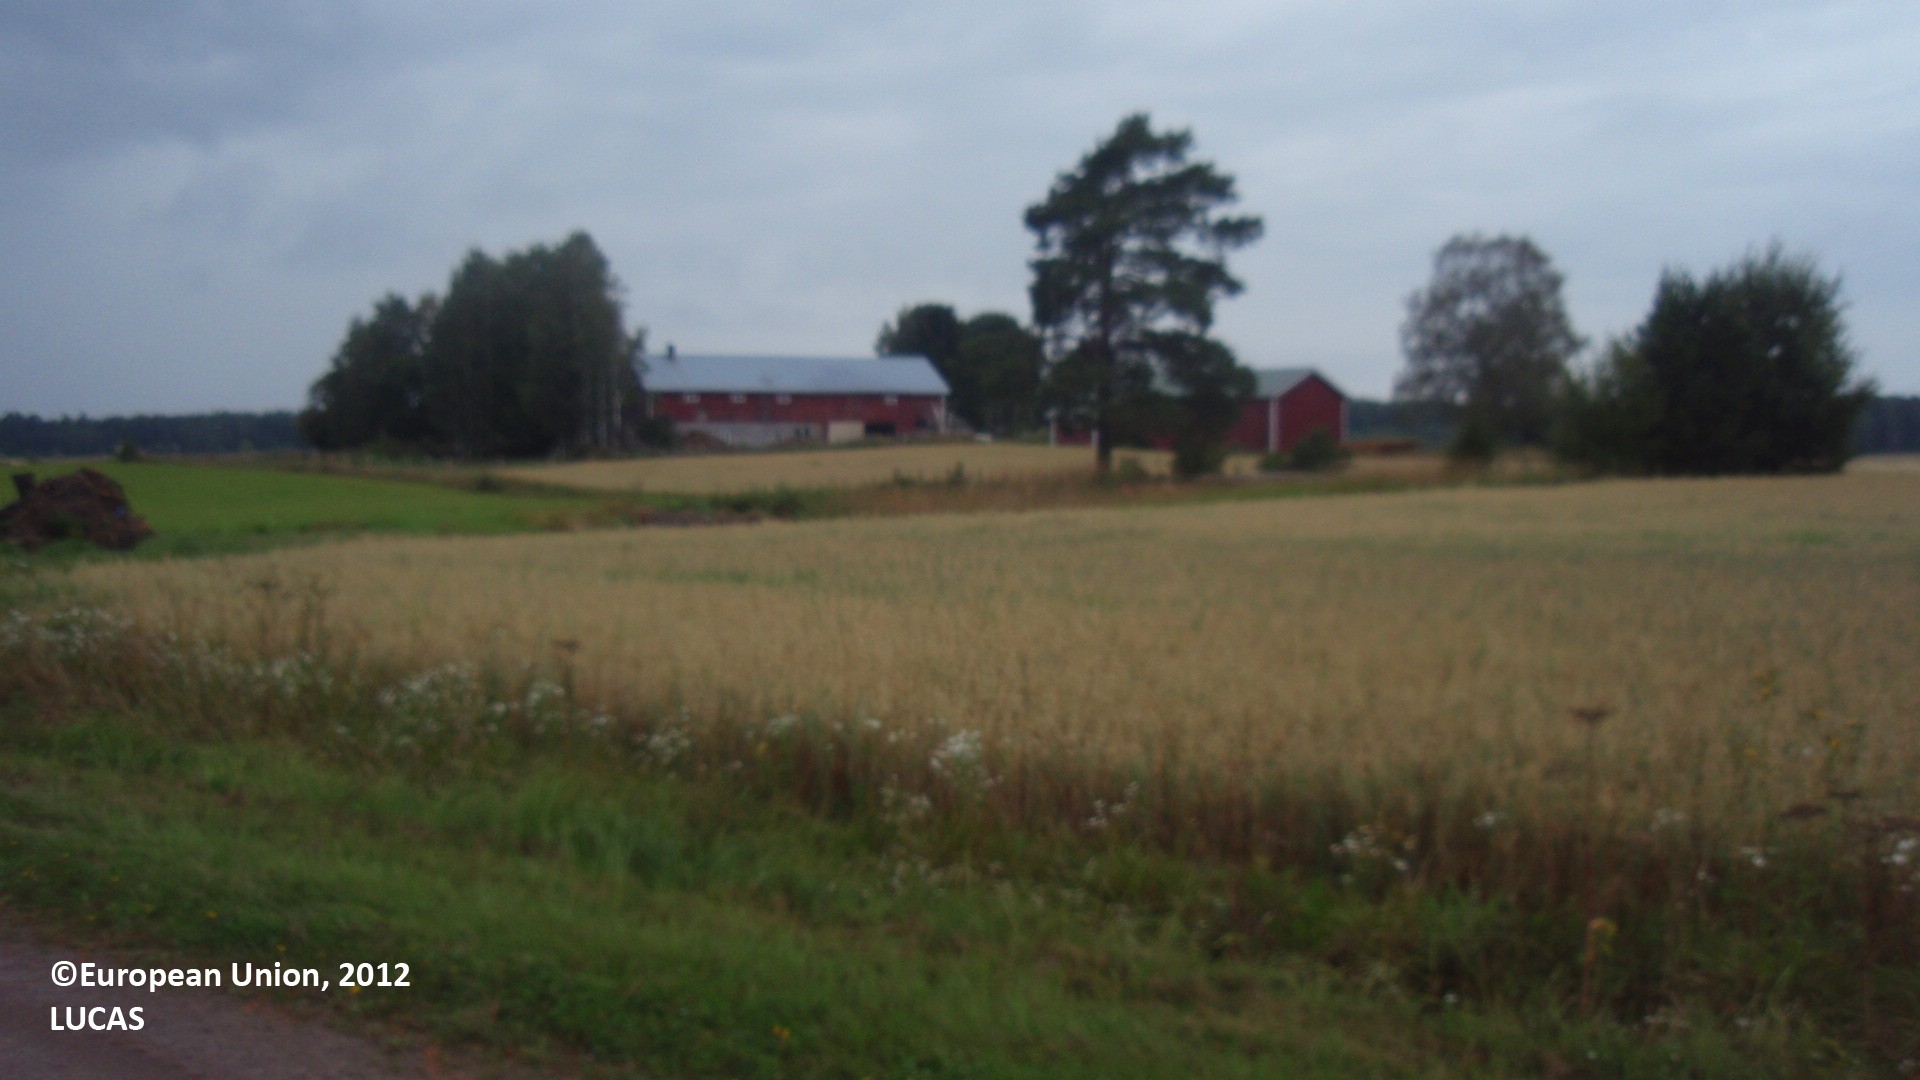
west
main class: Cropland
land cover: Oats
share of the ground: > 75 %
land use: Agriculture (excluding fallow land and kitchen gardens)
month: August
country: FI
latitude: 60.7375
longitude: 26.9103
